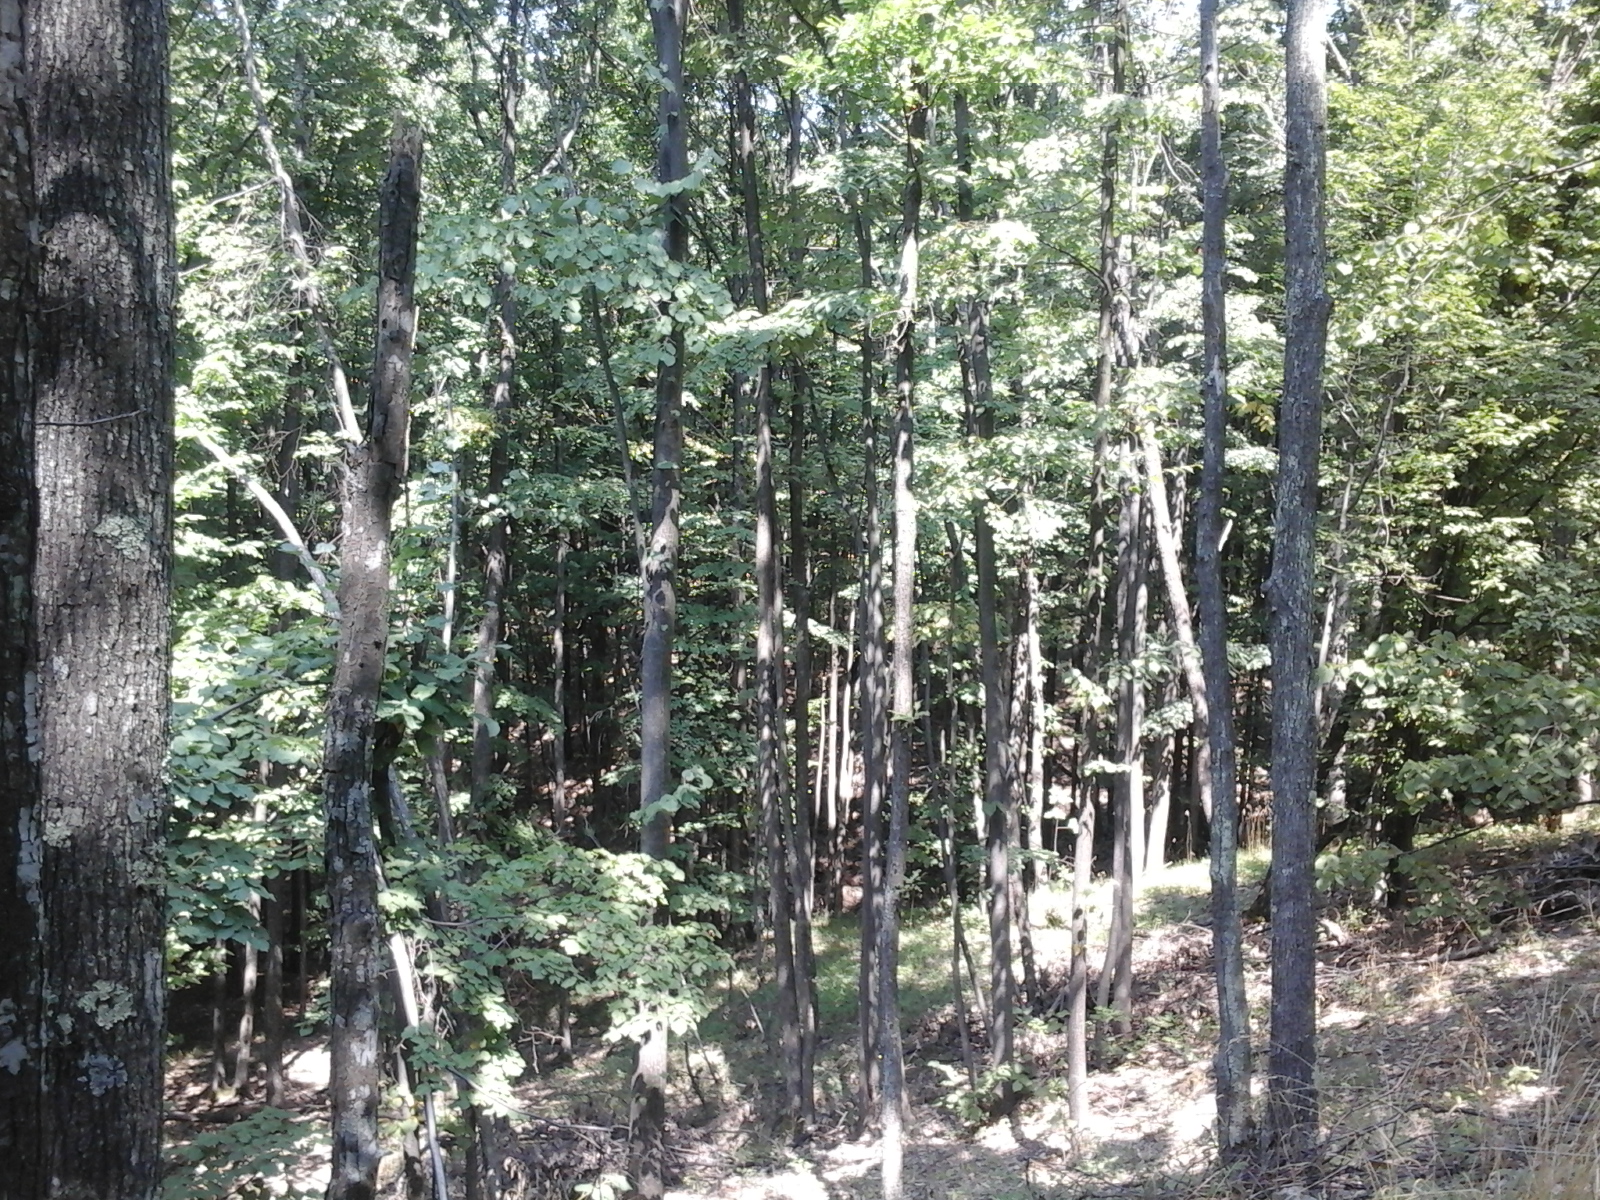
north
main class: Woodland
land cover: Broadleaved woodland
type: acidophilous oak and oak-birch forest
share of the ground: > 75 %
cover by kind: broadleaved forest trees 100 %
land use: Forestry
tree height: > 5 m
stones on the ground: < 10 %
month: August
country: RO
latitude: 44.8048
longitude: 23.8554
